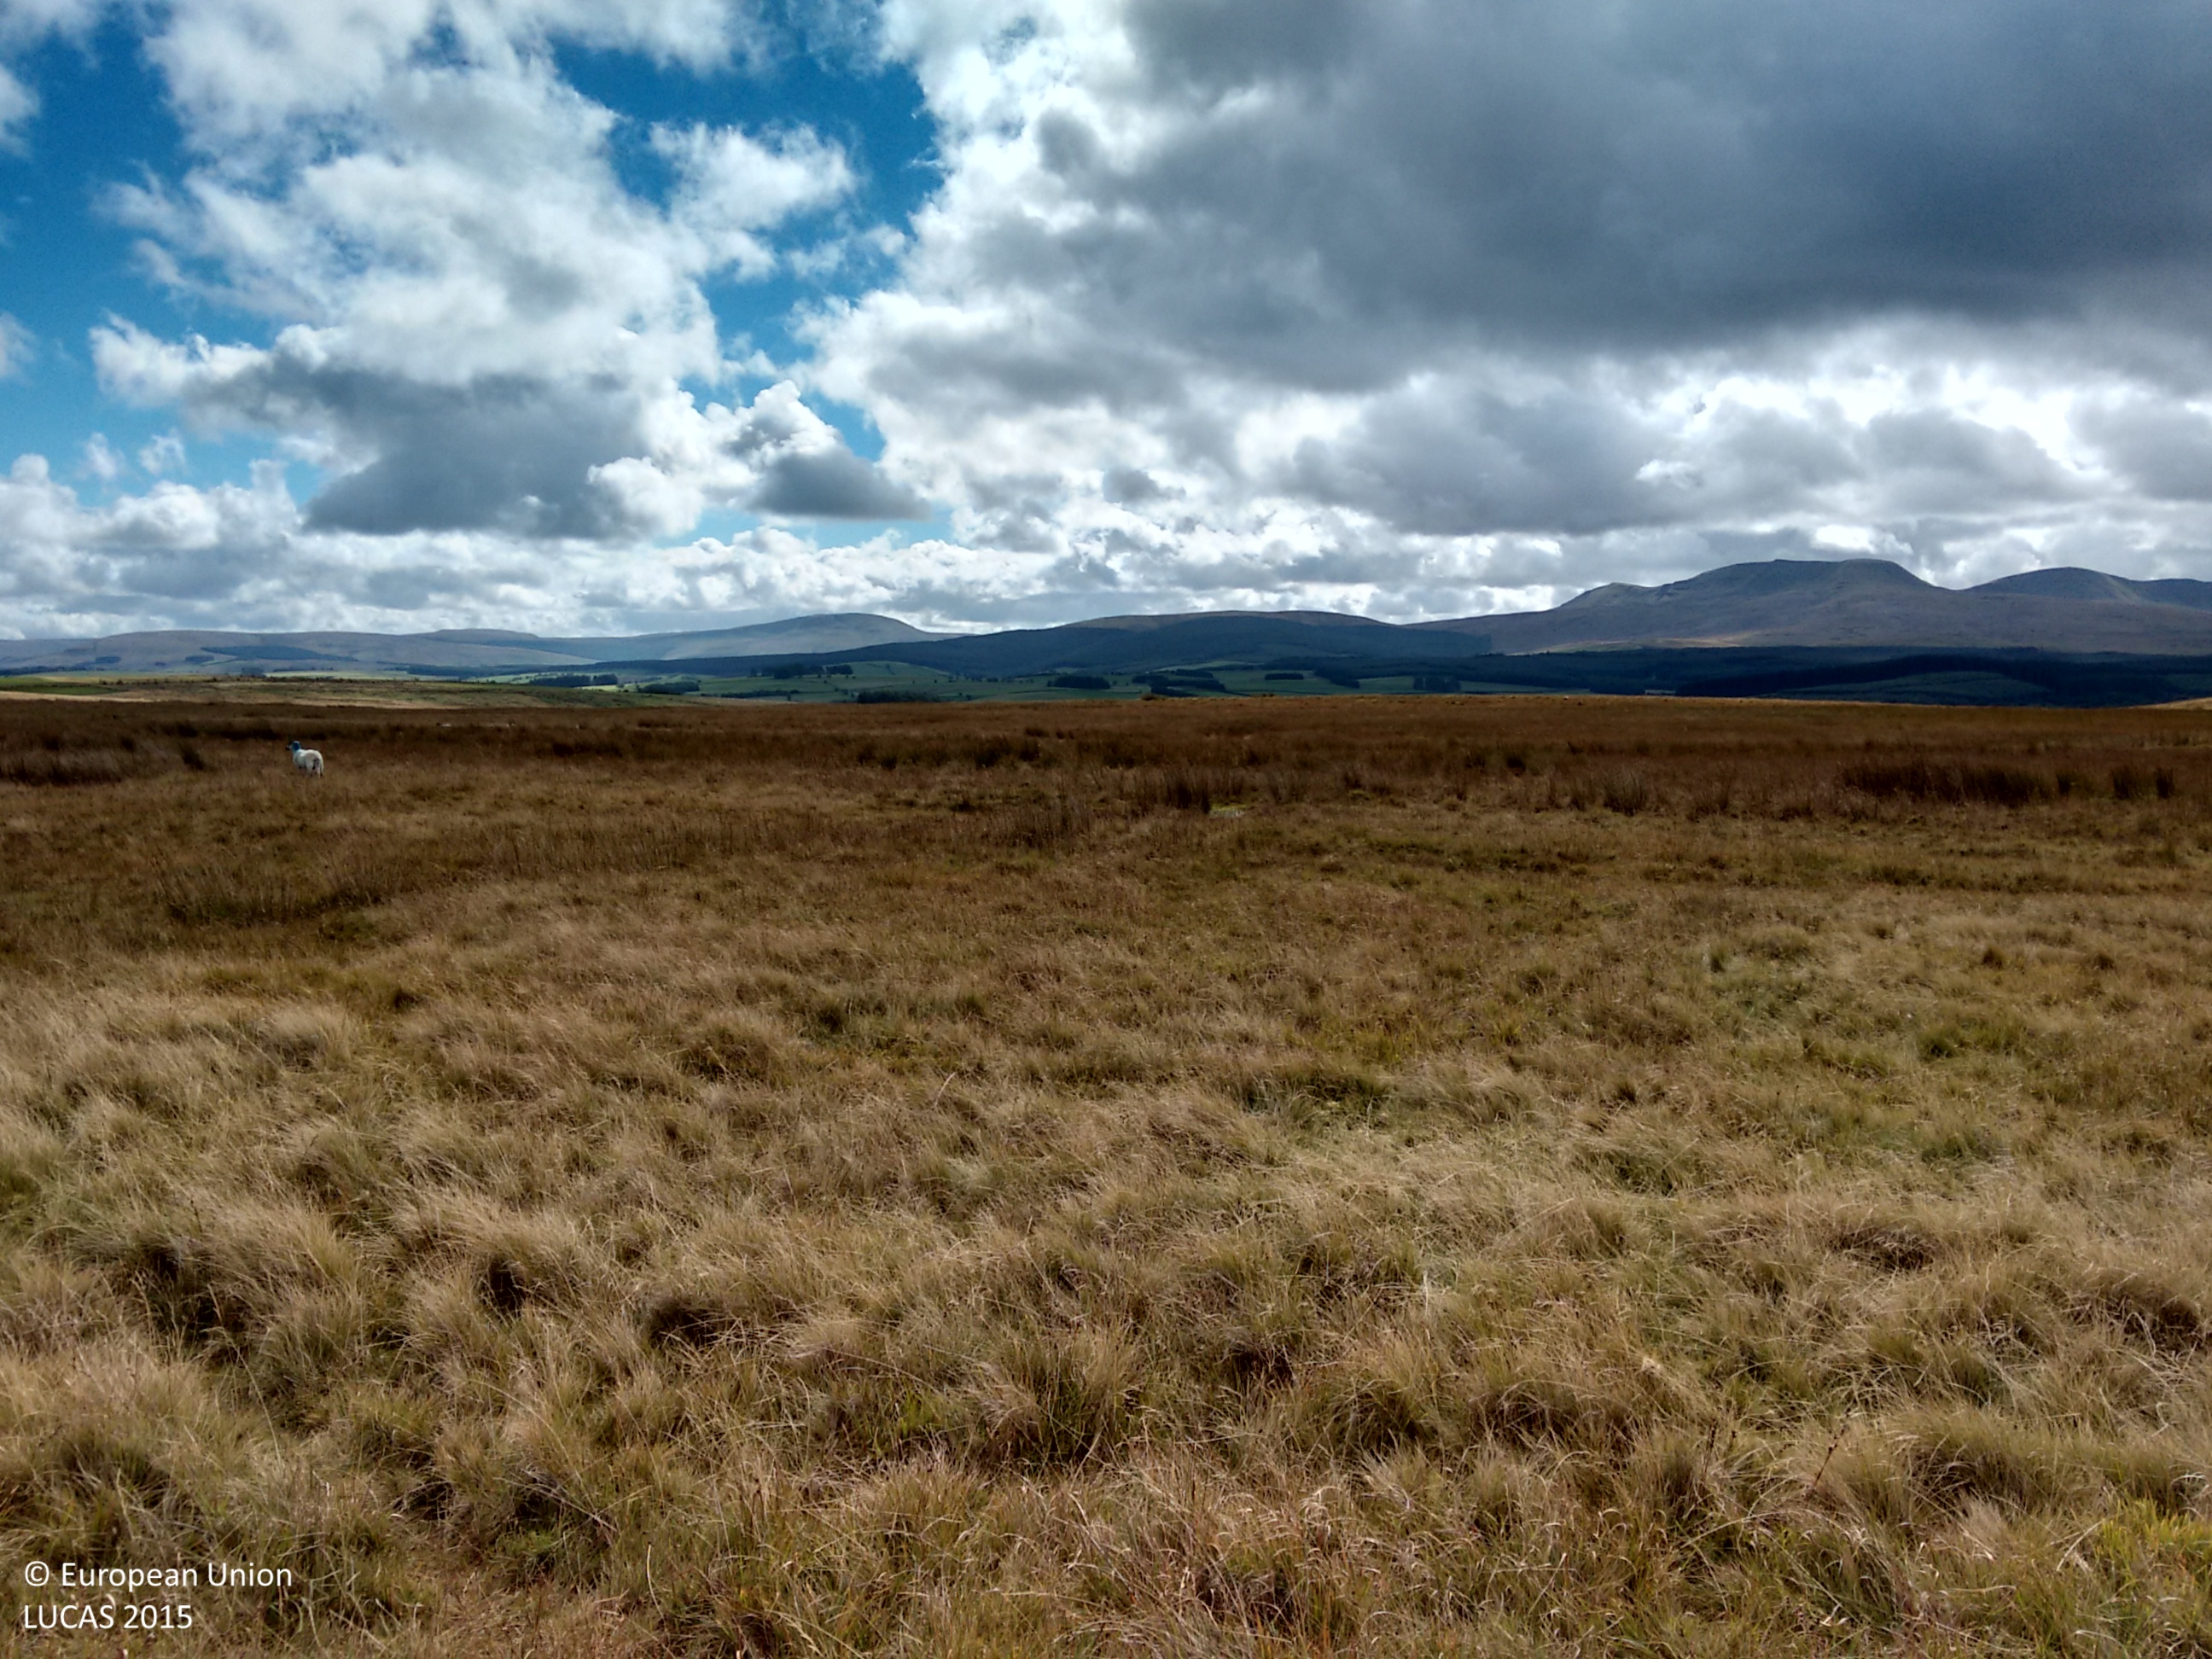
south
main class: Grassland
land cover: Grassland without tree/shrub cover
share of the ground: > 75 %
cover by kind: herbaceous plants 100 %
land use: Agriculture (excluding fallow land and kitchen gardens)
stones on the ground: < 10 %
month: September
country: GB
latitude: 51.9618
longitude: -3.6958
